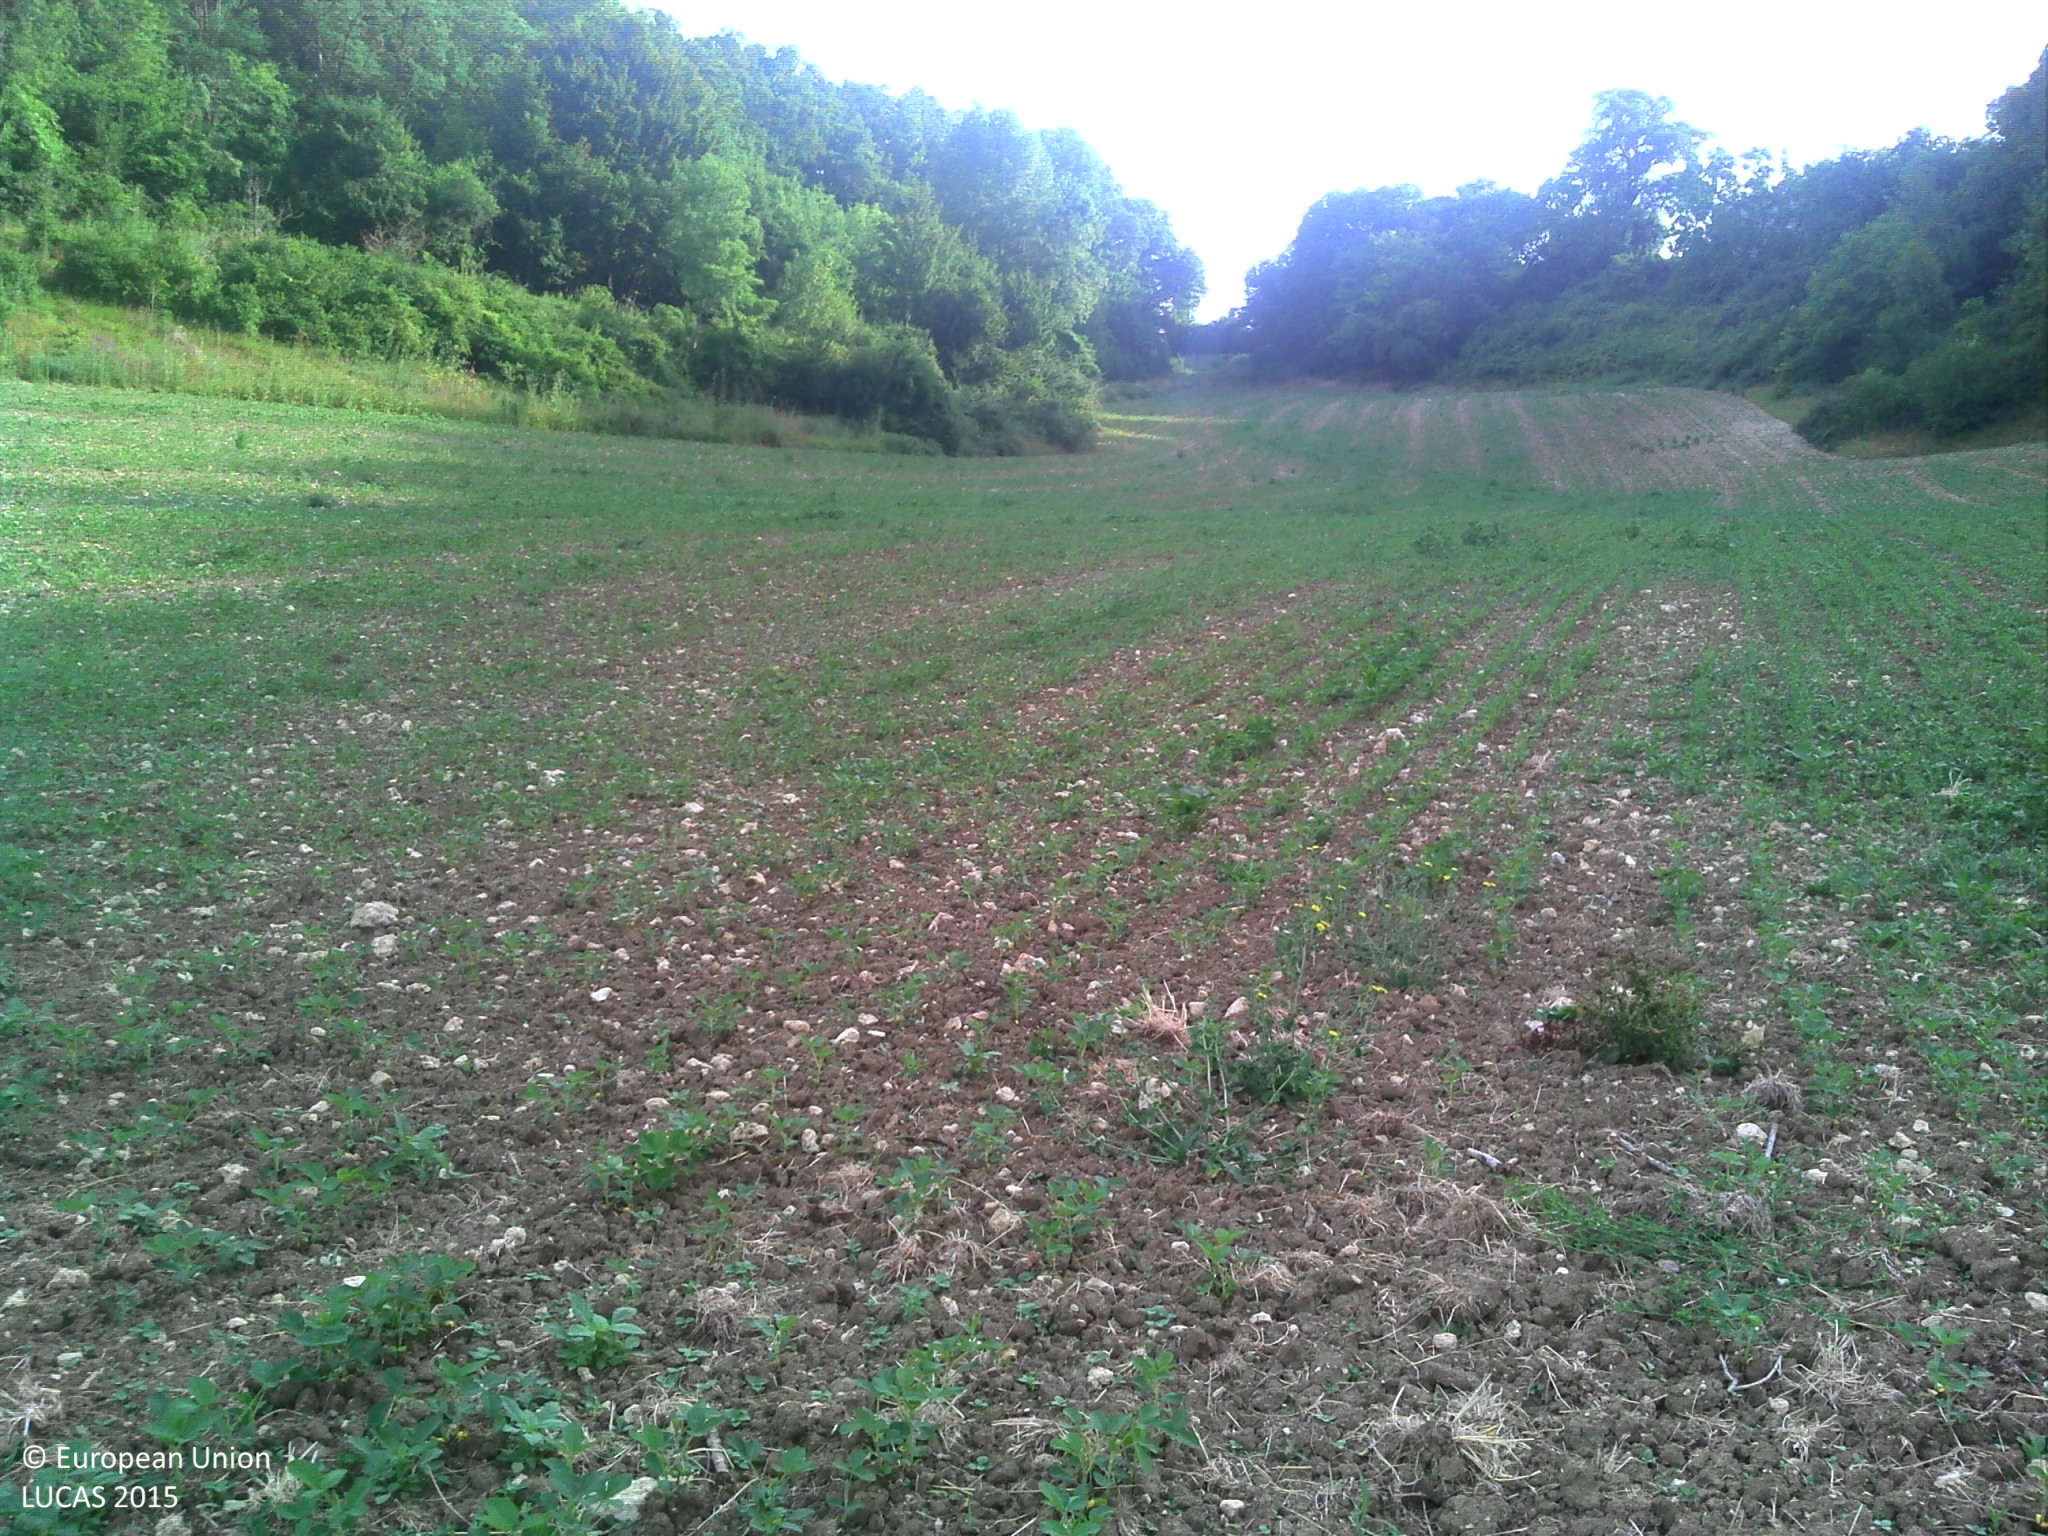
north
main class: Cropland
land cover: Soya
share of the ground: > 75 %
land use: Agriculture (excluding fallow land and kitchen gardens)
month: July
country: FR
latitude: 44.3134
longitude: 0.9065
